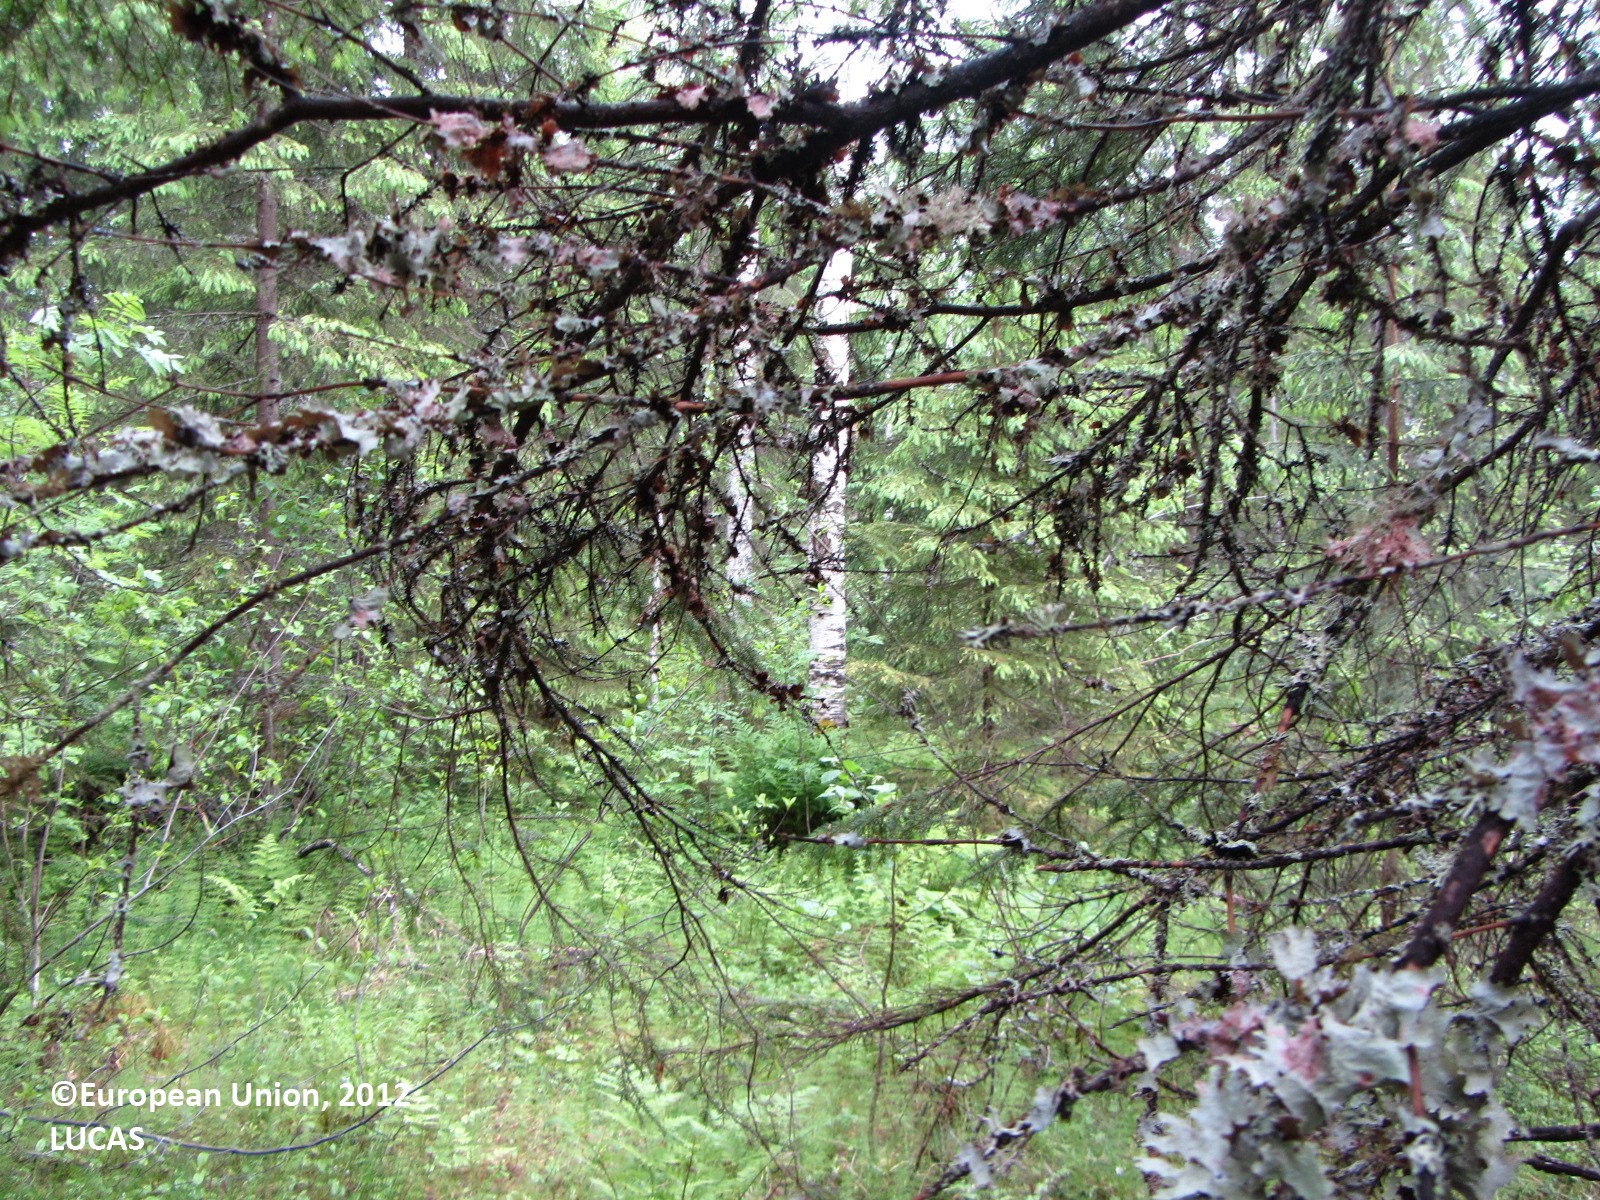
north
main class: Woodland
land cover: Spruce dominated coniferous woodland
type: boreal forest
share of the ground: > 75 %
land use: Forestry
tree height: > 5 m
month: June
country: FI
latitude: 62.4345
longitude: 25.2739
